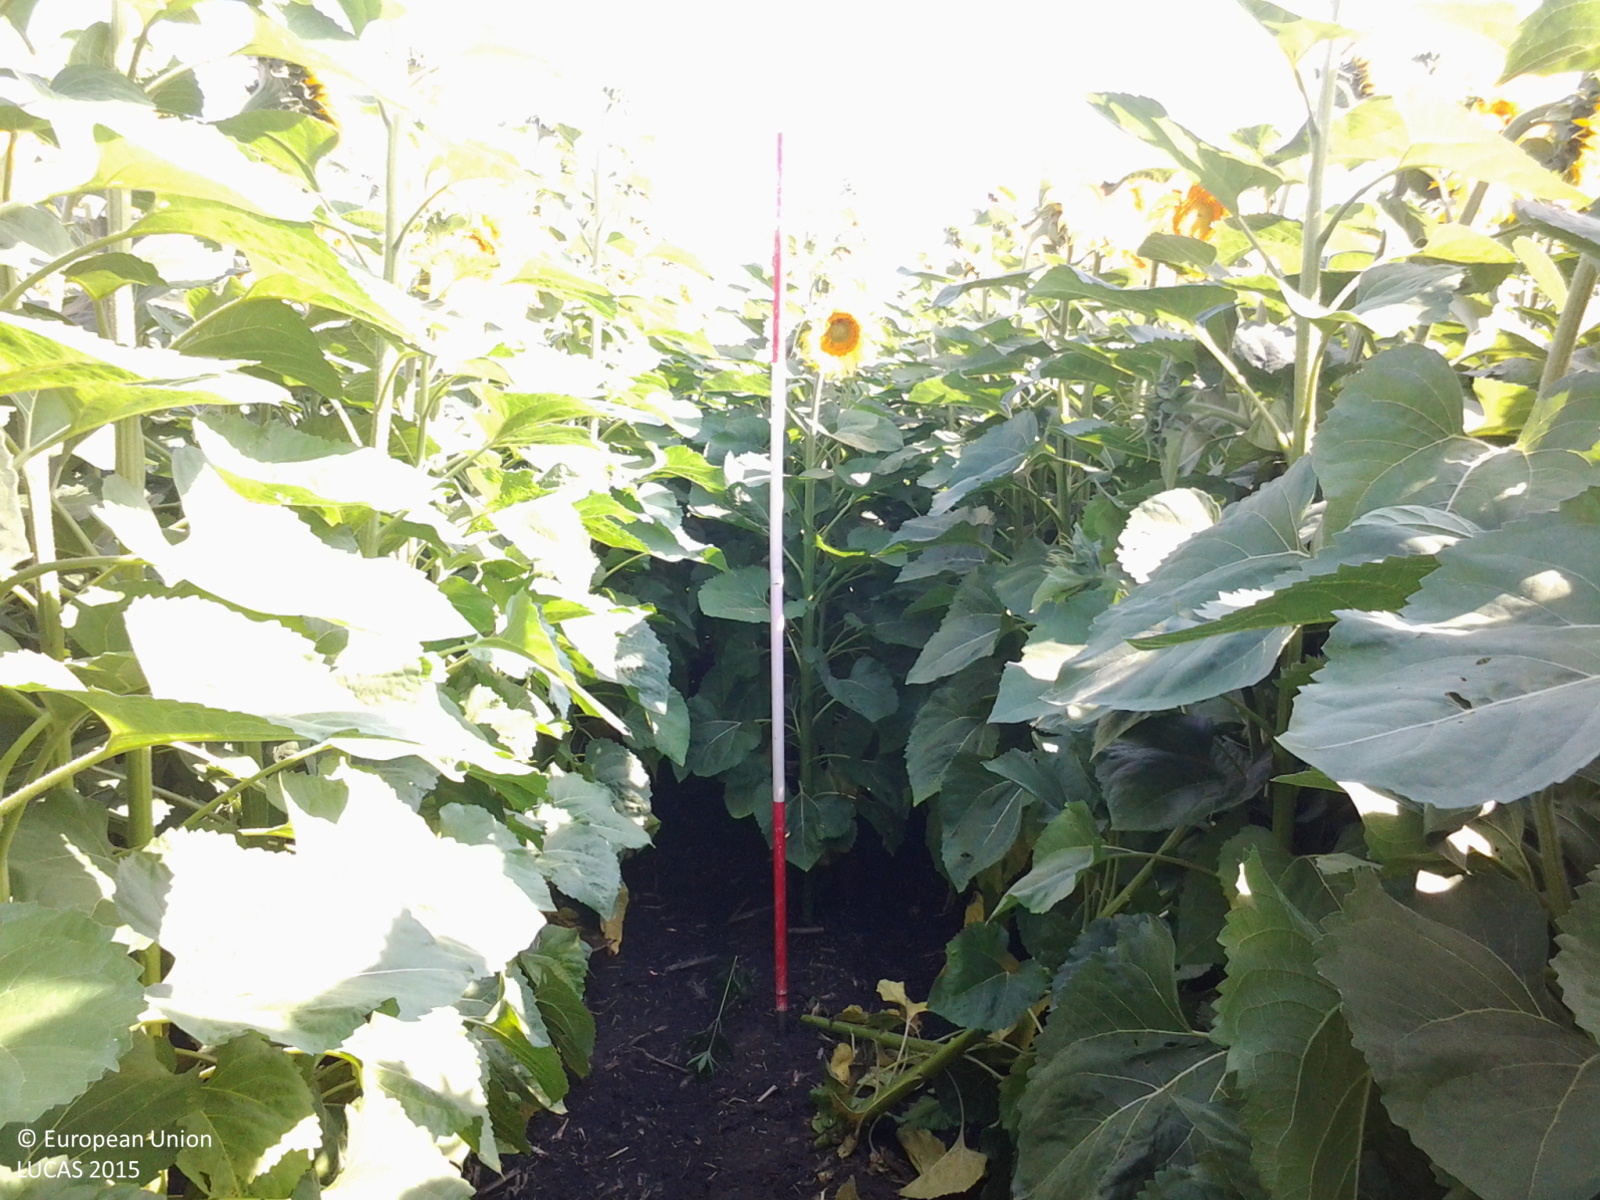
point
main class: Cropland
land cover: Sunflower
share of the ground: > 75 %
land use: Agriculture (excluding fallow land and kitchen gardens)
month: July
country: HU
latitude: 47.0930
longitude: 20.6091
